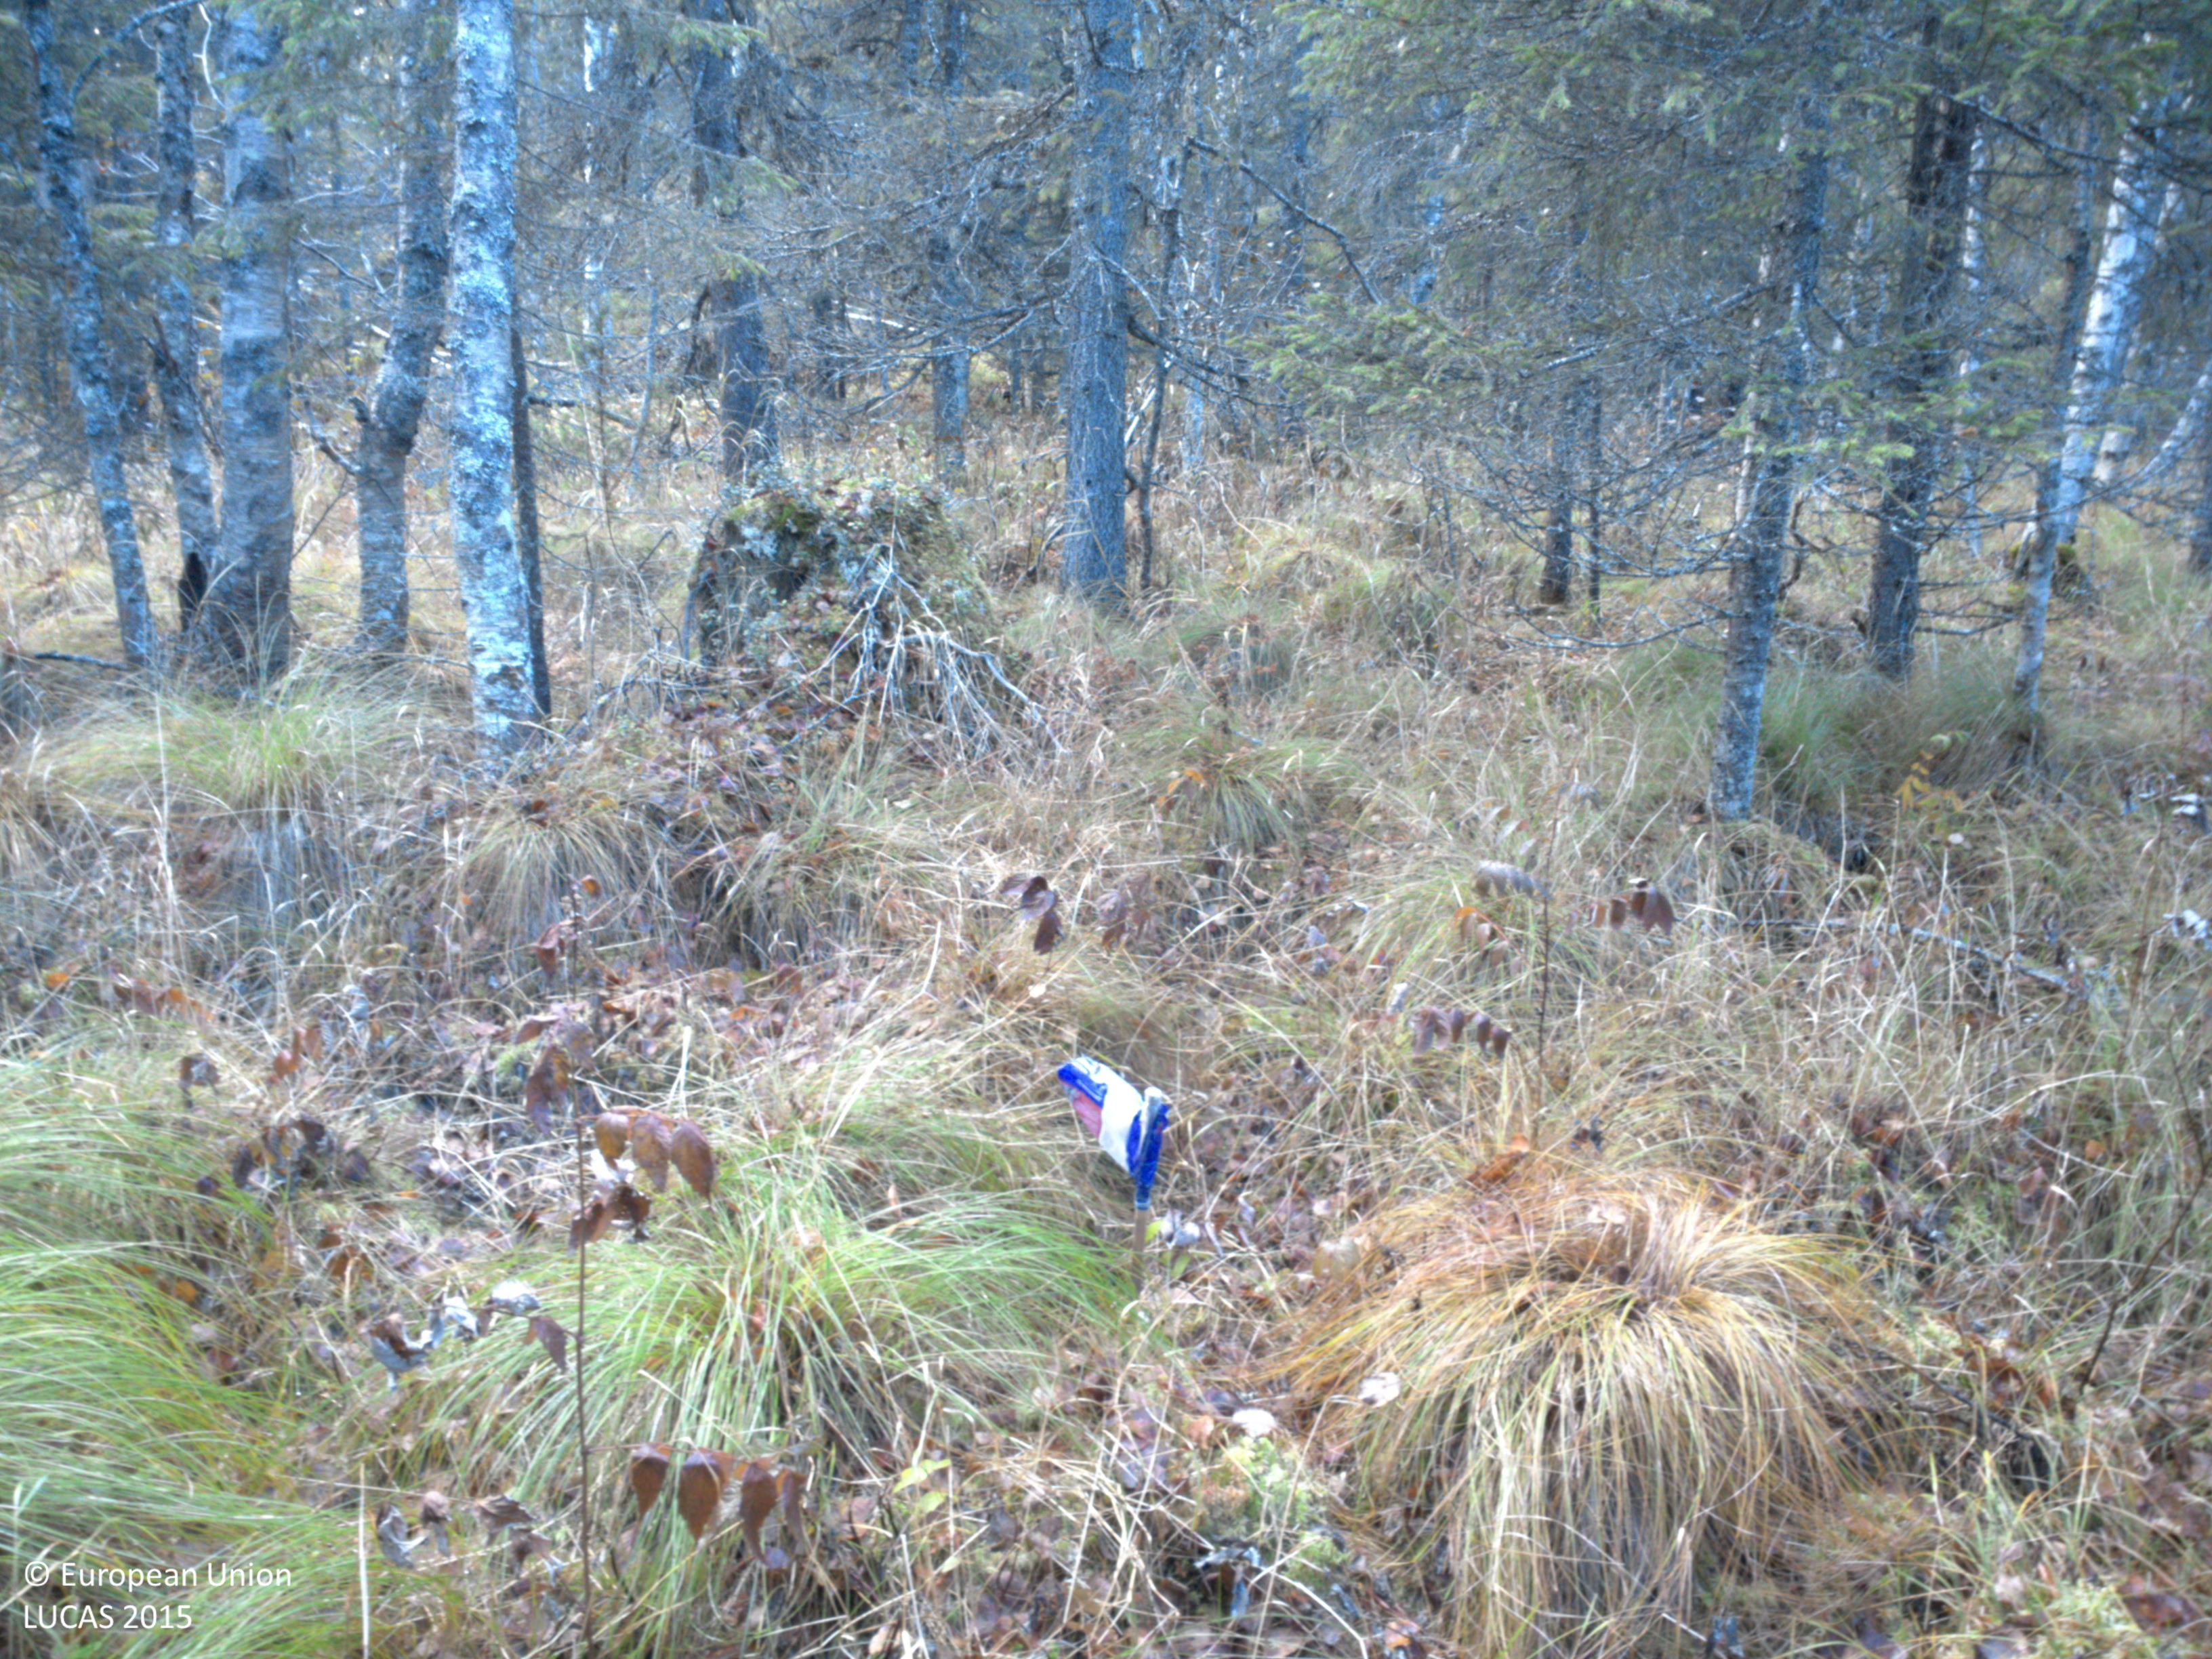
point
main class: Woodland
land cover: Spruce dominated mixed woodland
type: boreal forest
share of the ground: > 75 %
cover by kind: coniferous forest trees 55 %, broadleaved forest trees 25 %, shrubs 10 %, herbaceous plants 5 %, lichens and mosses 5 %
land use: Forestry
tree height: > 5 m
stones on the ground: < 10 %
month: October
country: SE
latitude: 64.0457
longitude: 18.1013
